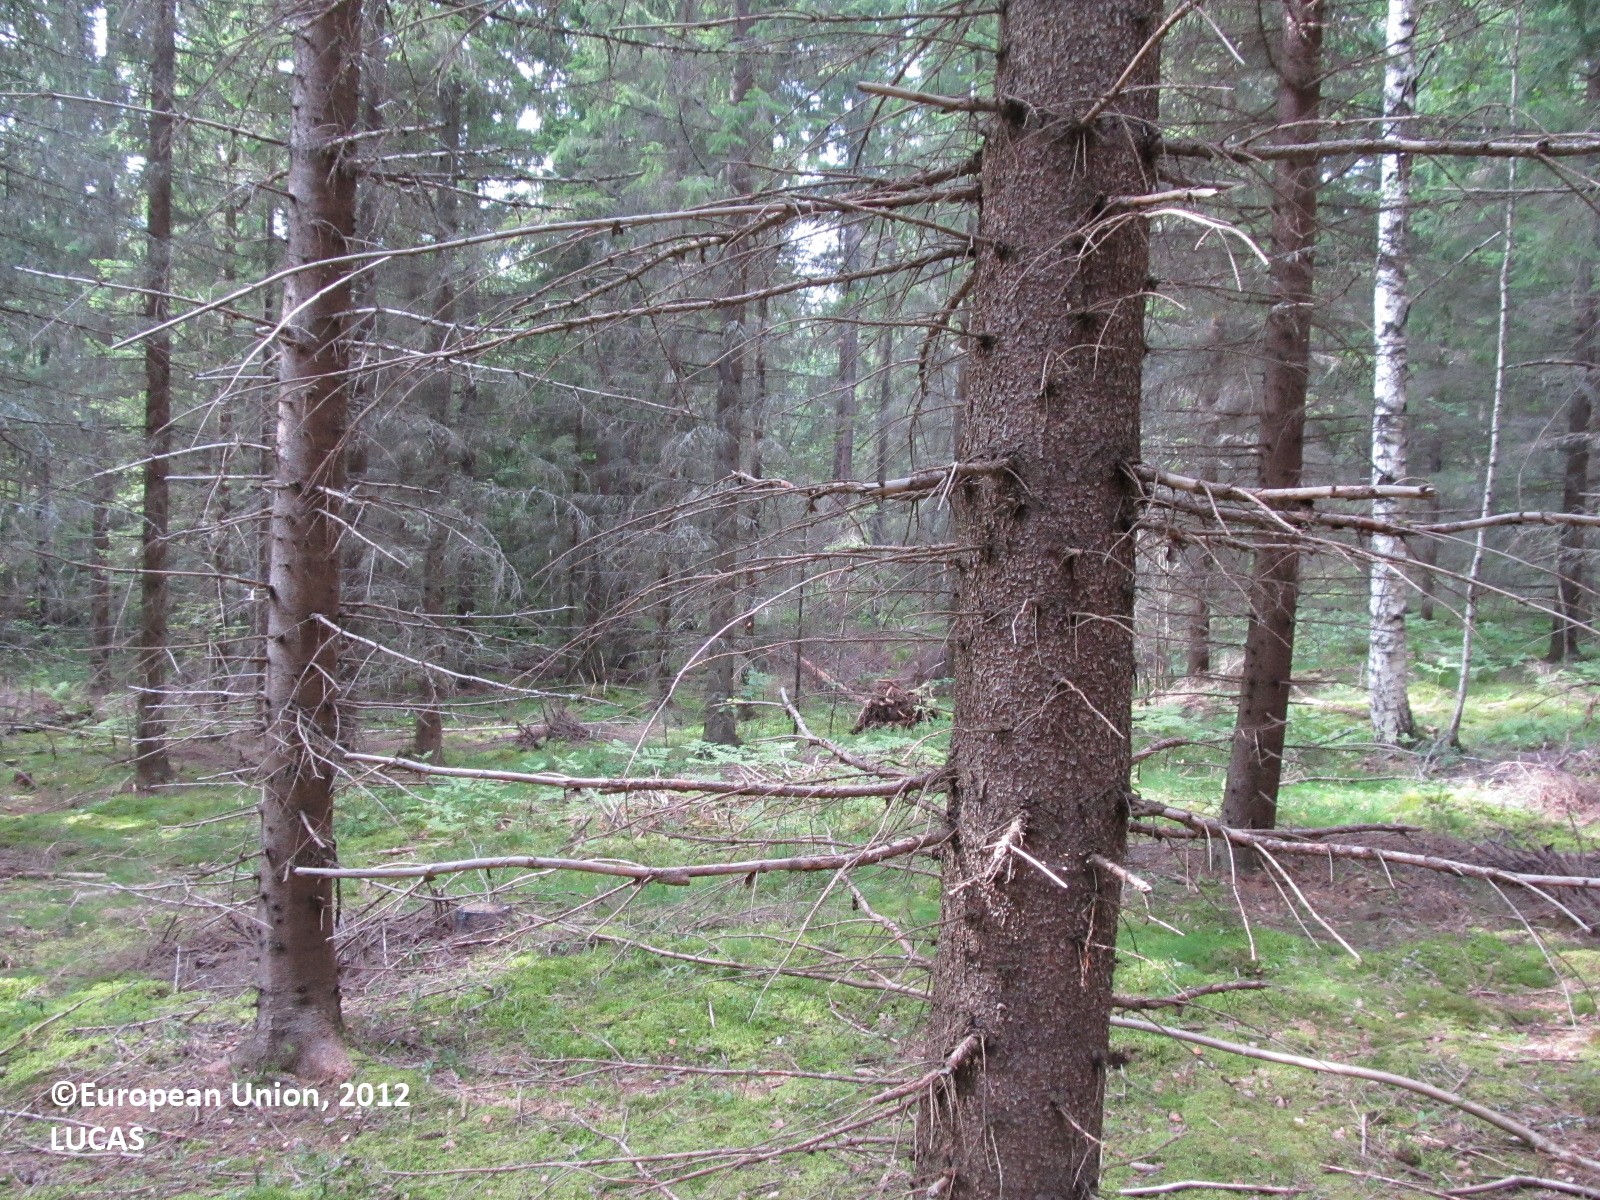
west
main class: Woodland
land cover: Spruce dominated coniferous woodland
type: boreal forest
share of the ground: 50 - 75 %
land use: Forestry
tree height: > 5 m
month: August
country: FI
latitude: 61.6625
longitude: 27.6888
